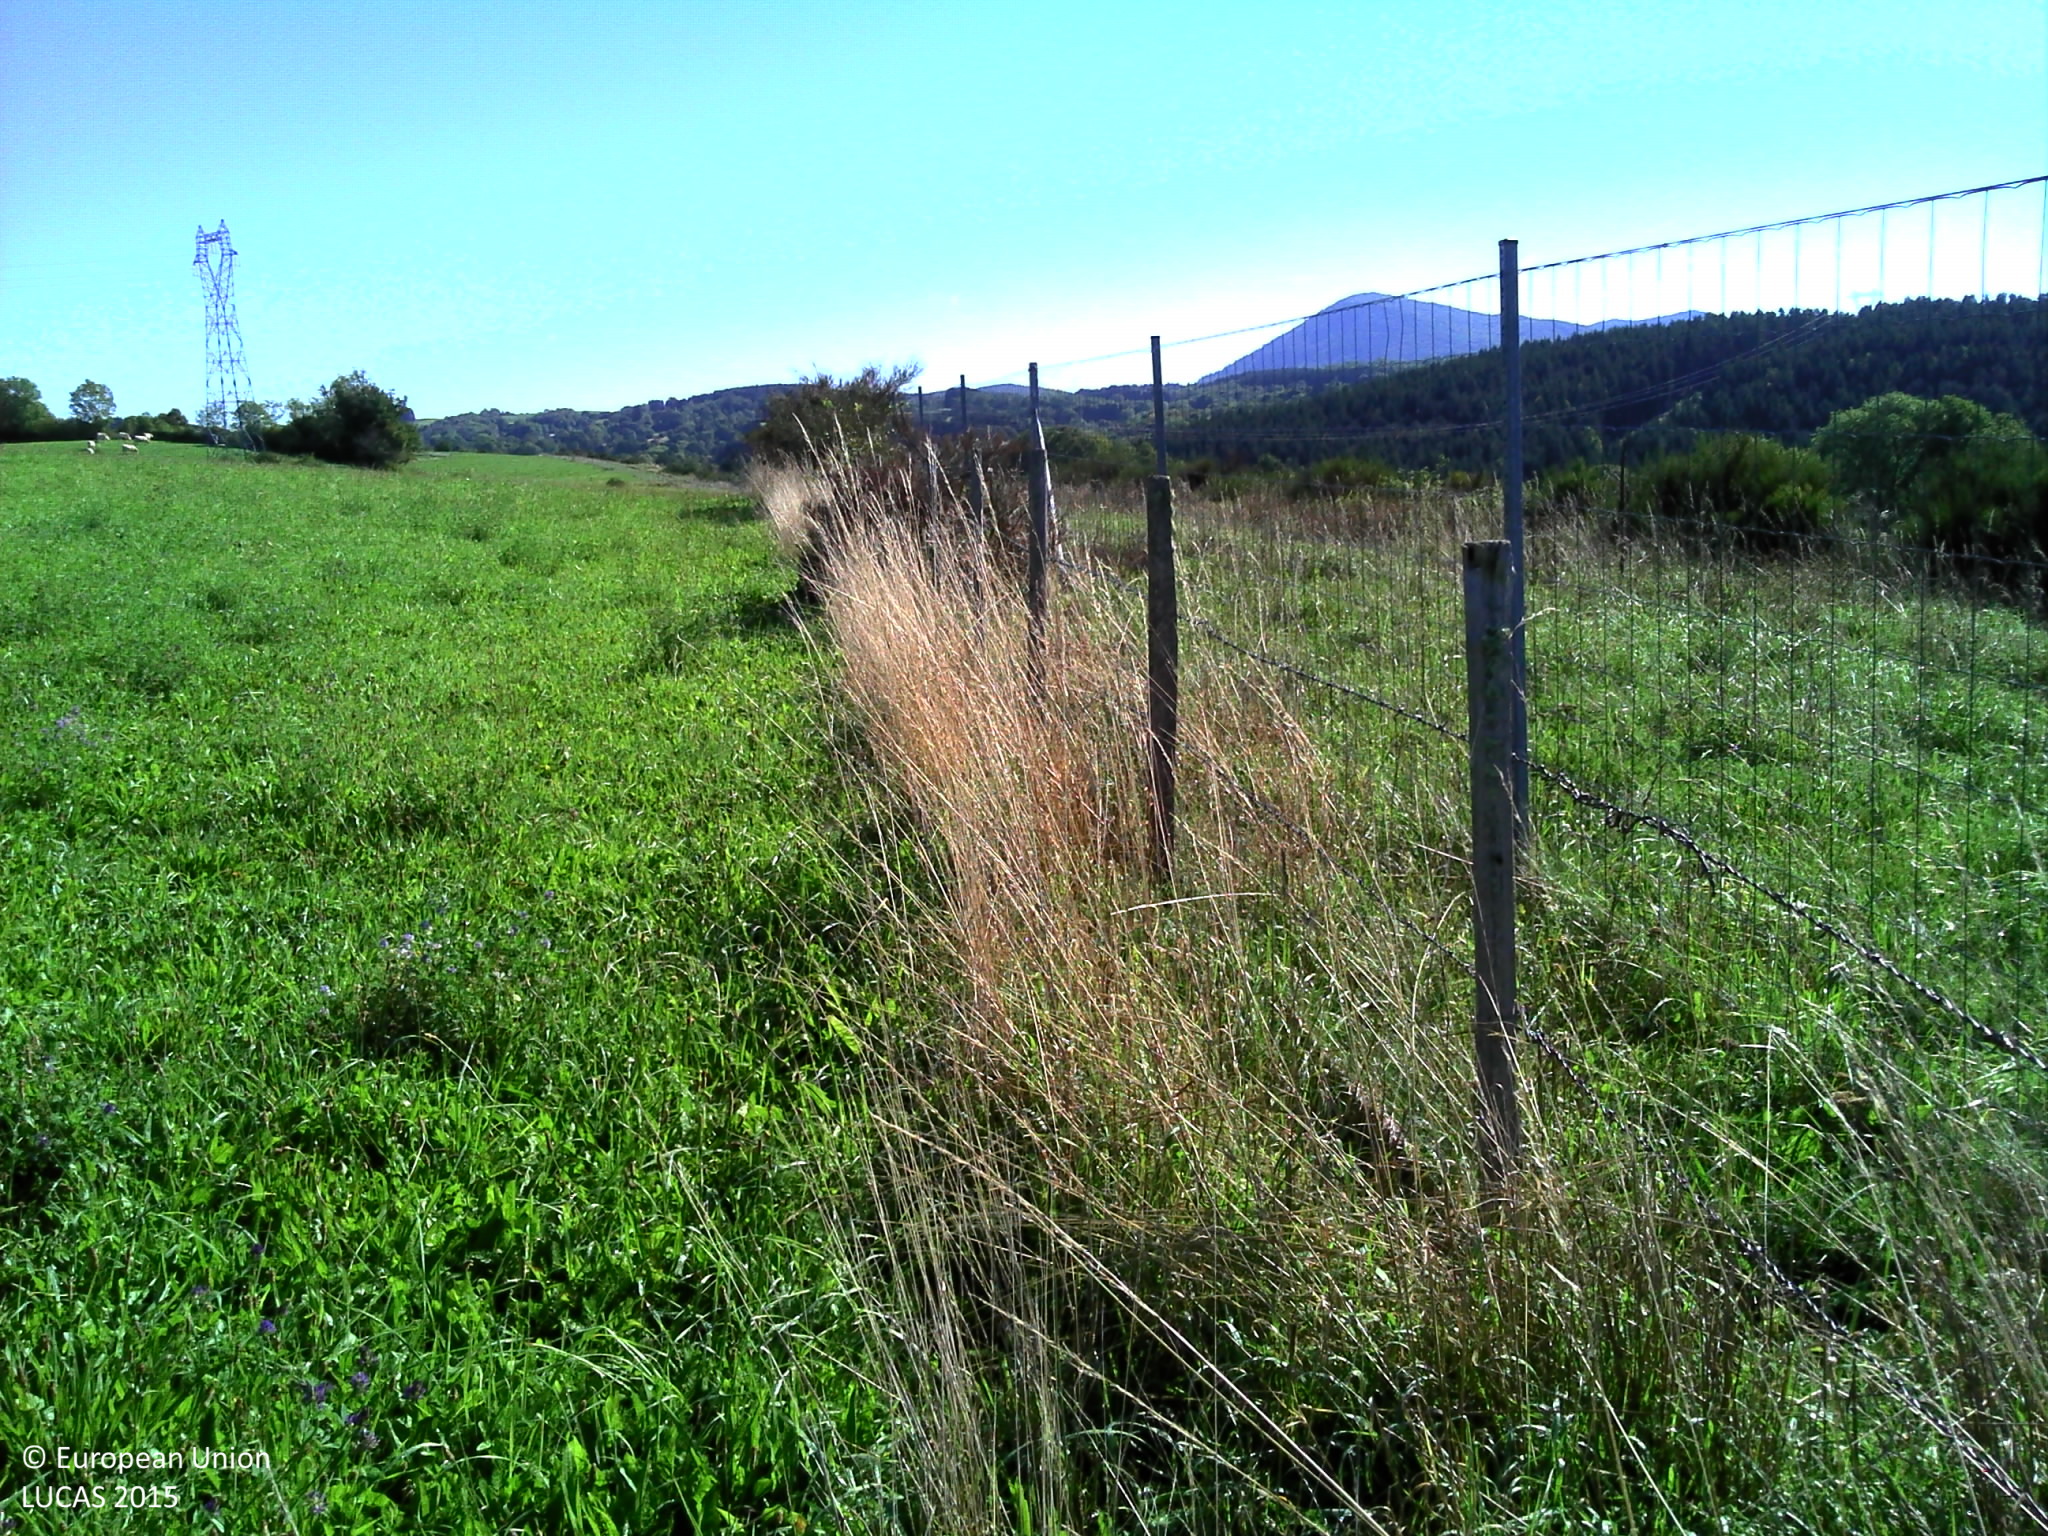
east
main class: Grassland
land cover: Grassland without tree/shrub cover
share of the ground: > 75 %
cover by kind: herbaceous plants 100 %
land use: Road transport
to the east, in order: Grassland without tree/shrub cover; Paved roads, cycling and walking lanes; Grassland without tree/shrub cover; Shrubland without tree cover; Tracks; Fences; Spontaneously vegetated surfaces
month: September
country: FR
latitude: 45.8604
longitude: 2.8760
